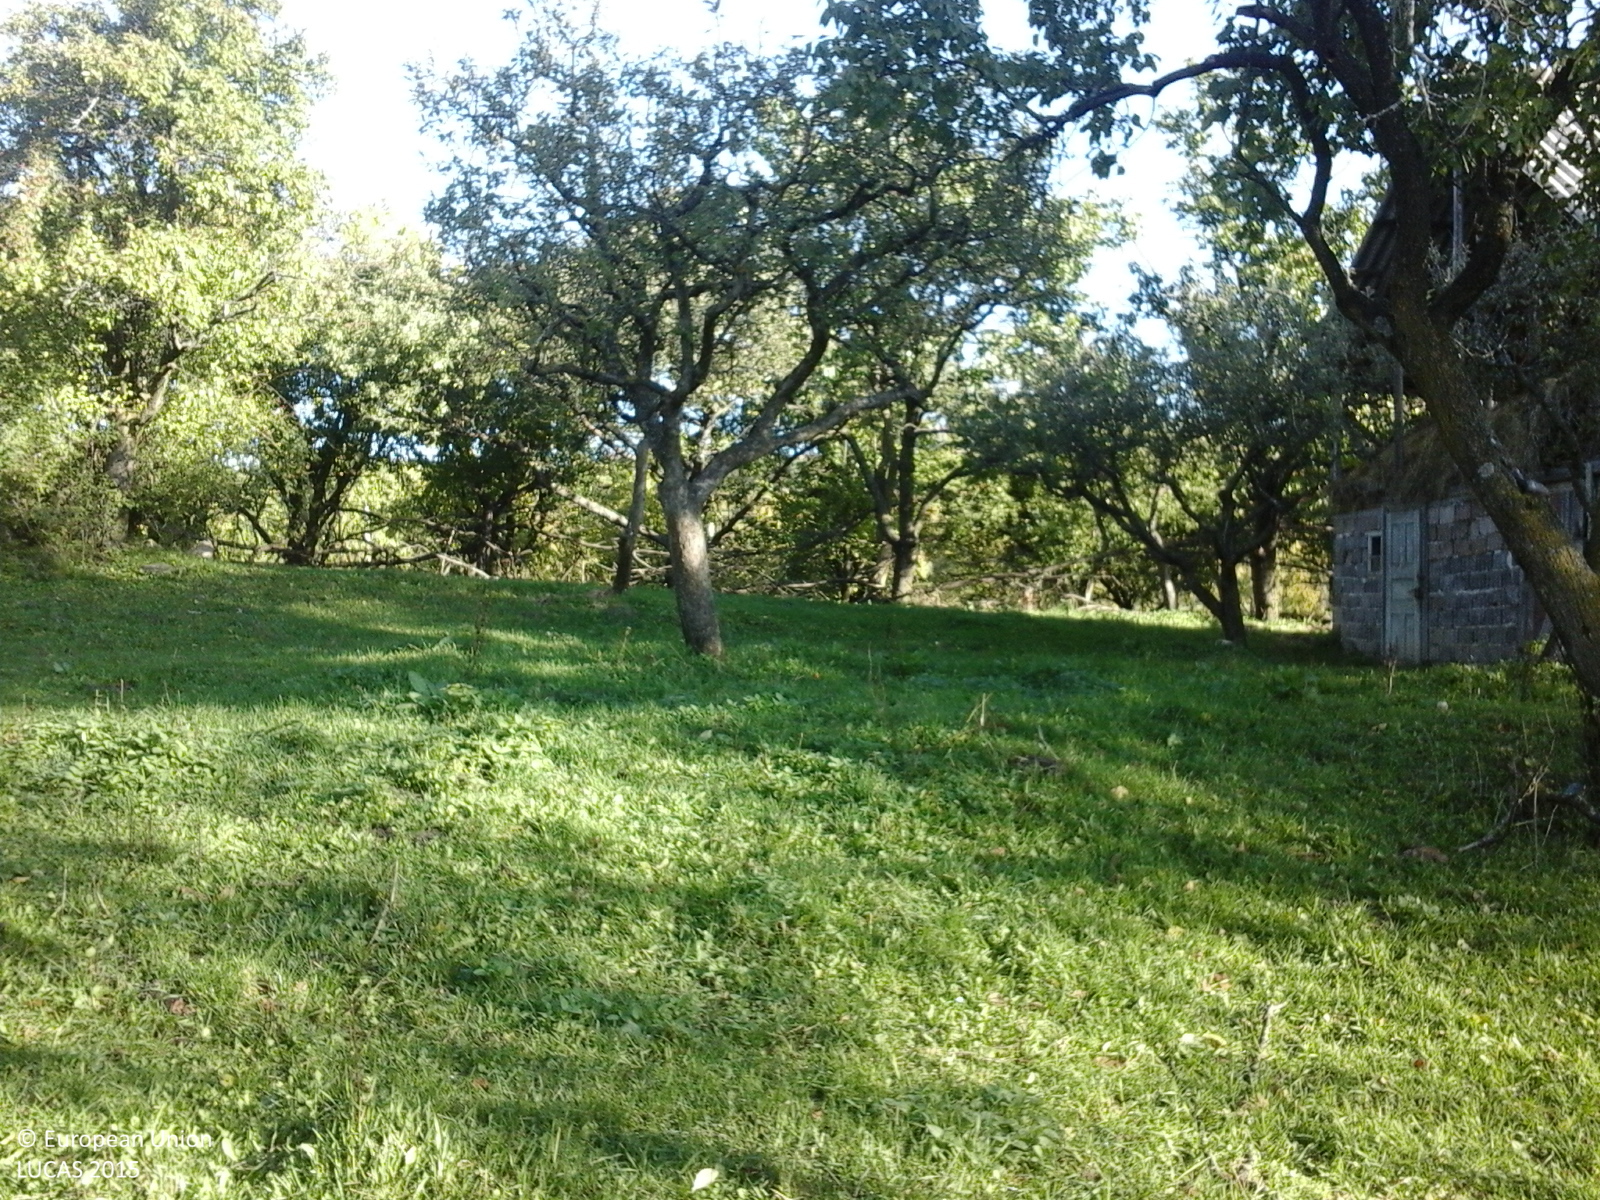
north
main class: Cropland
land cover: Other fruit trees and berries
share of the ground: > 75 %
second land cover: Grassland without tree/shrub cover
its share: > 75 %
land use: Agriculture (excluding fallow land and kitchen gardens)
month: October
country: RO
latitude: 45.2301
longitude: 25.1327
